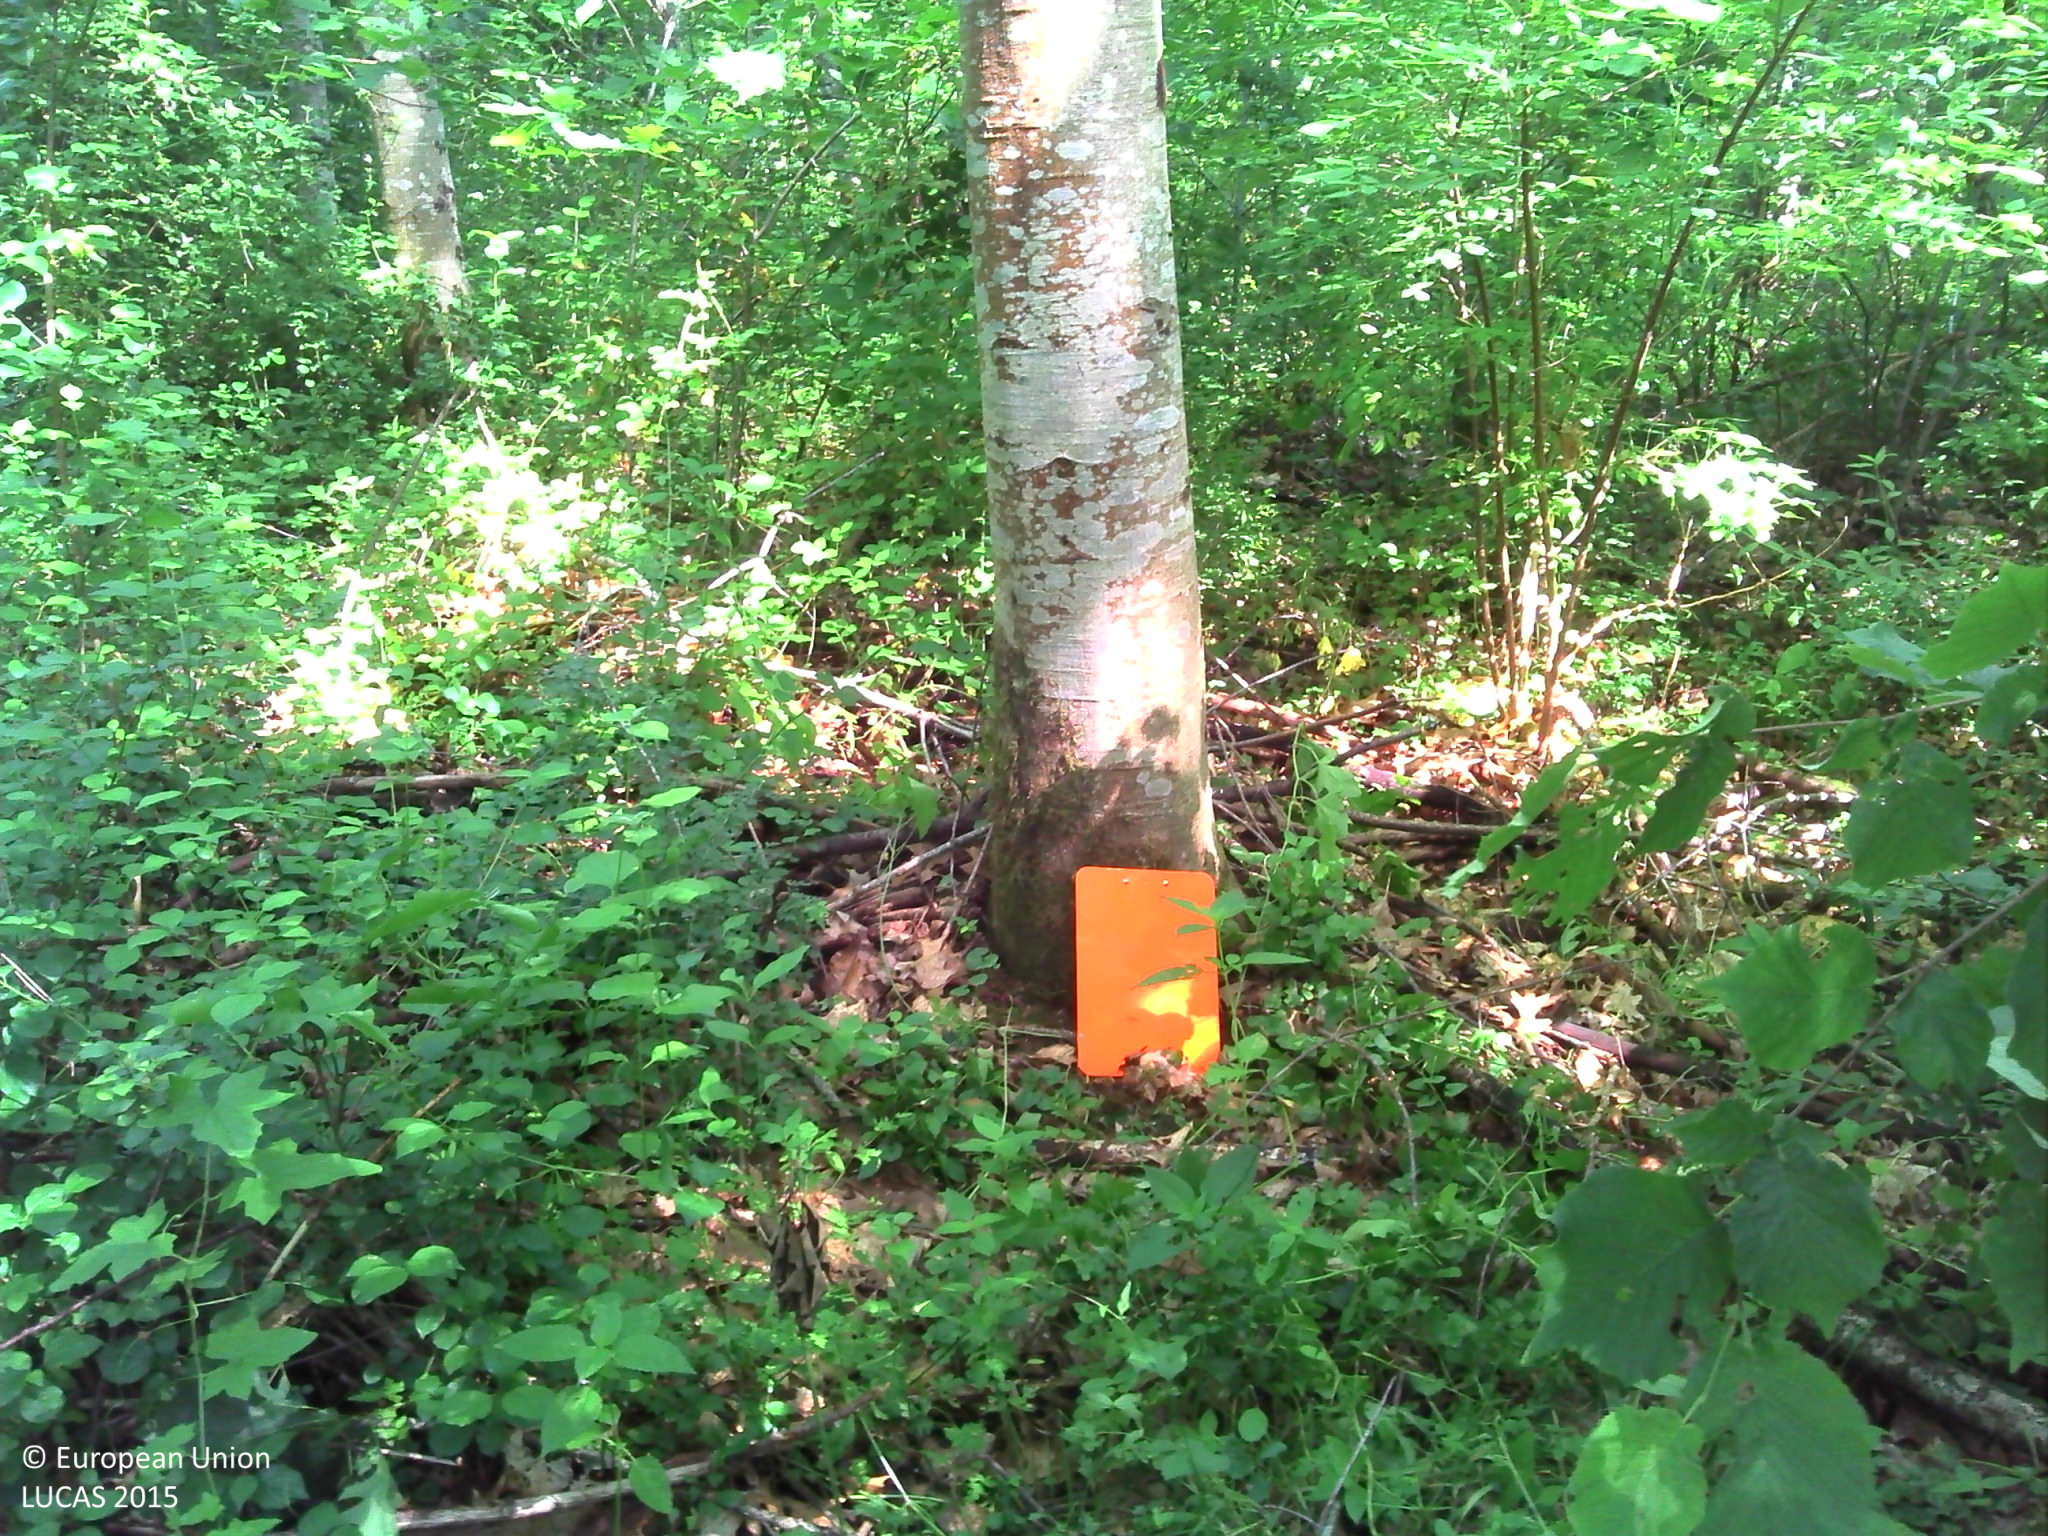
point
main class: Woodland
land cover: Broadleaved woodland
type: acidophilous oak and oak-birch forest
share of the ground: > 75 %
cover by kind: broadleaved forest trees 100 %
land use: Forestry
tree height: > 5 m
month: June
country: FR
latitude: 45.8704
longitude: 0.6727
